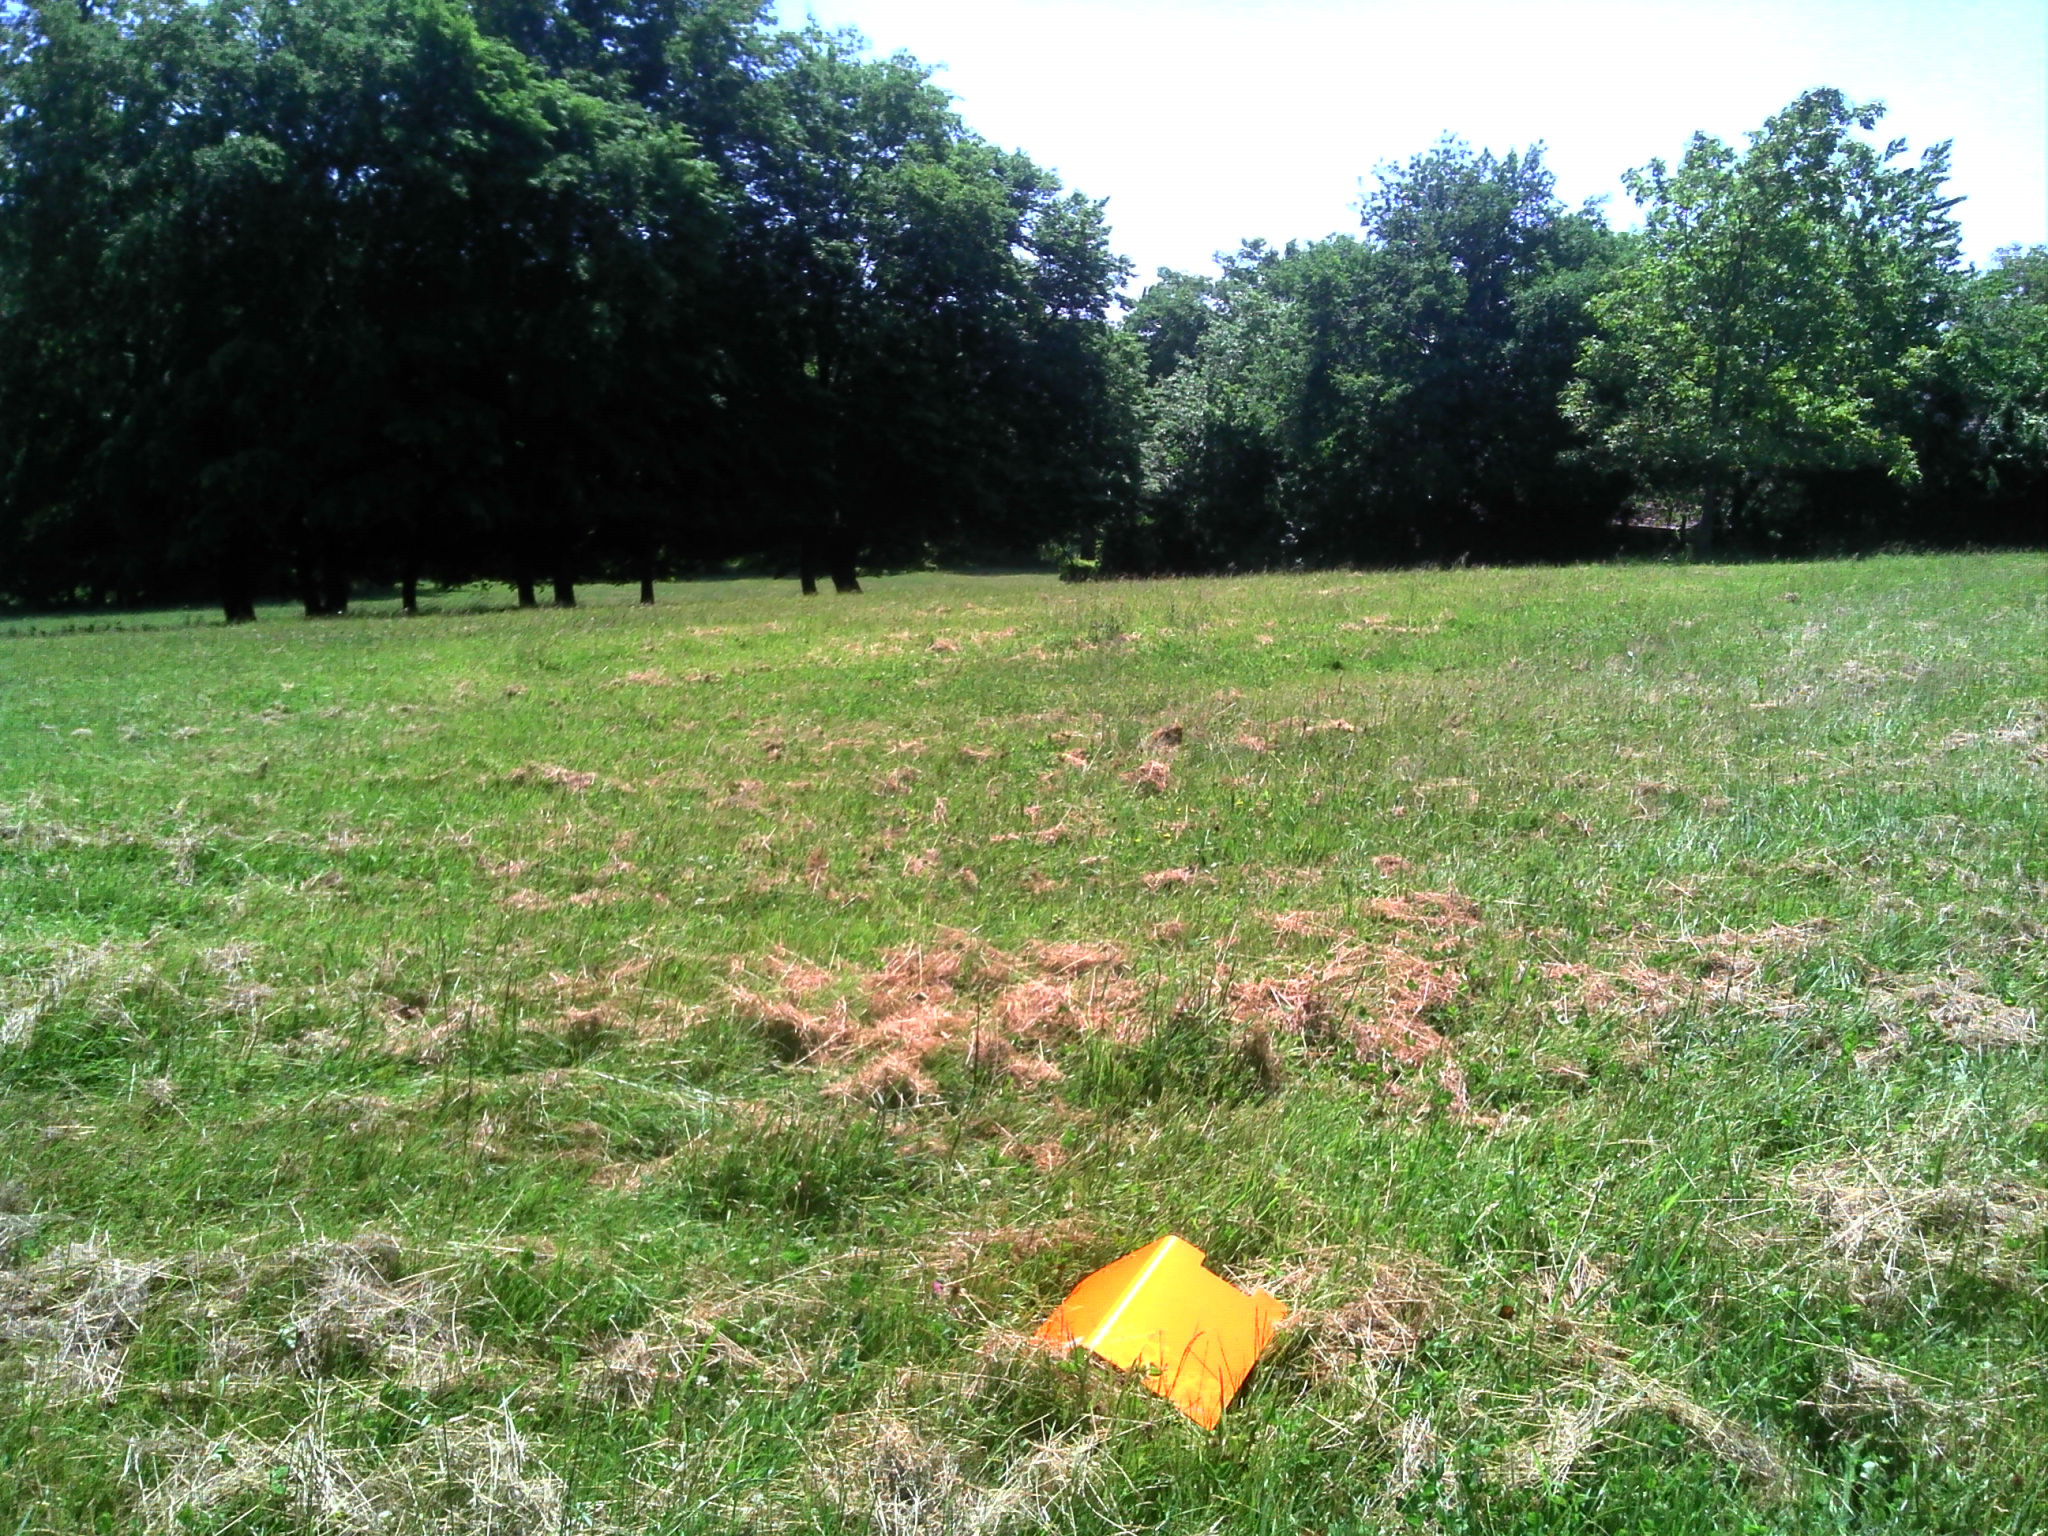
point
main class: Grassland
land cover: Grassland without tree/shrub cover
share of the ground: > 75 %
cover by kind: herbaceous plants 100 %
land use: Agriculture (excluding fallow land and kitchen gardens)
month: May
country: FR
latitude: 46.5282
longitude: 5.1133
